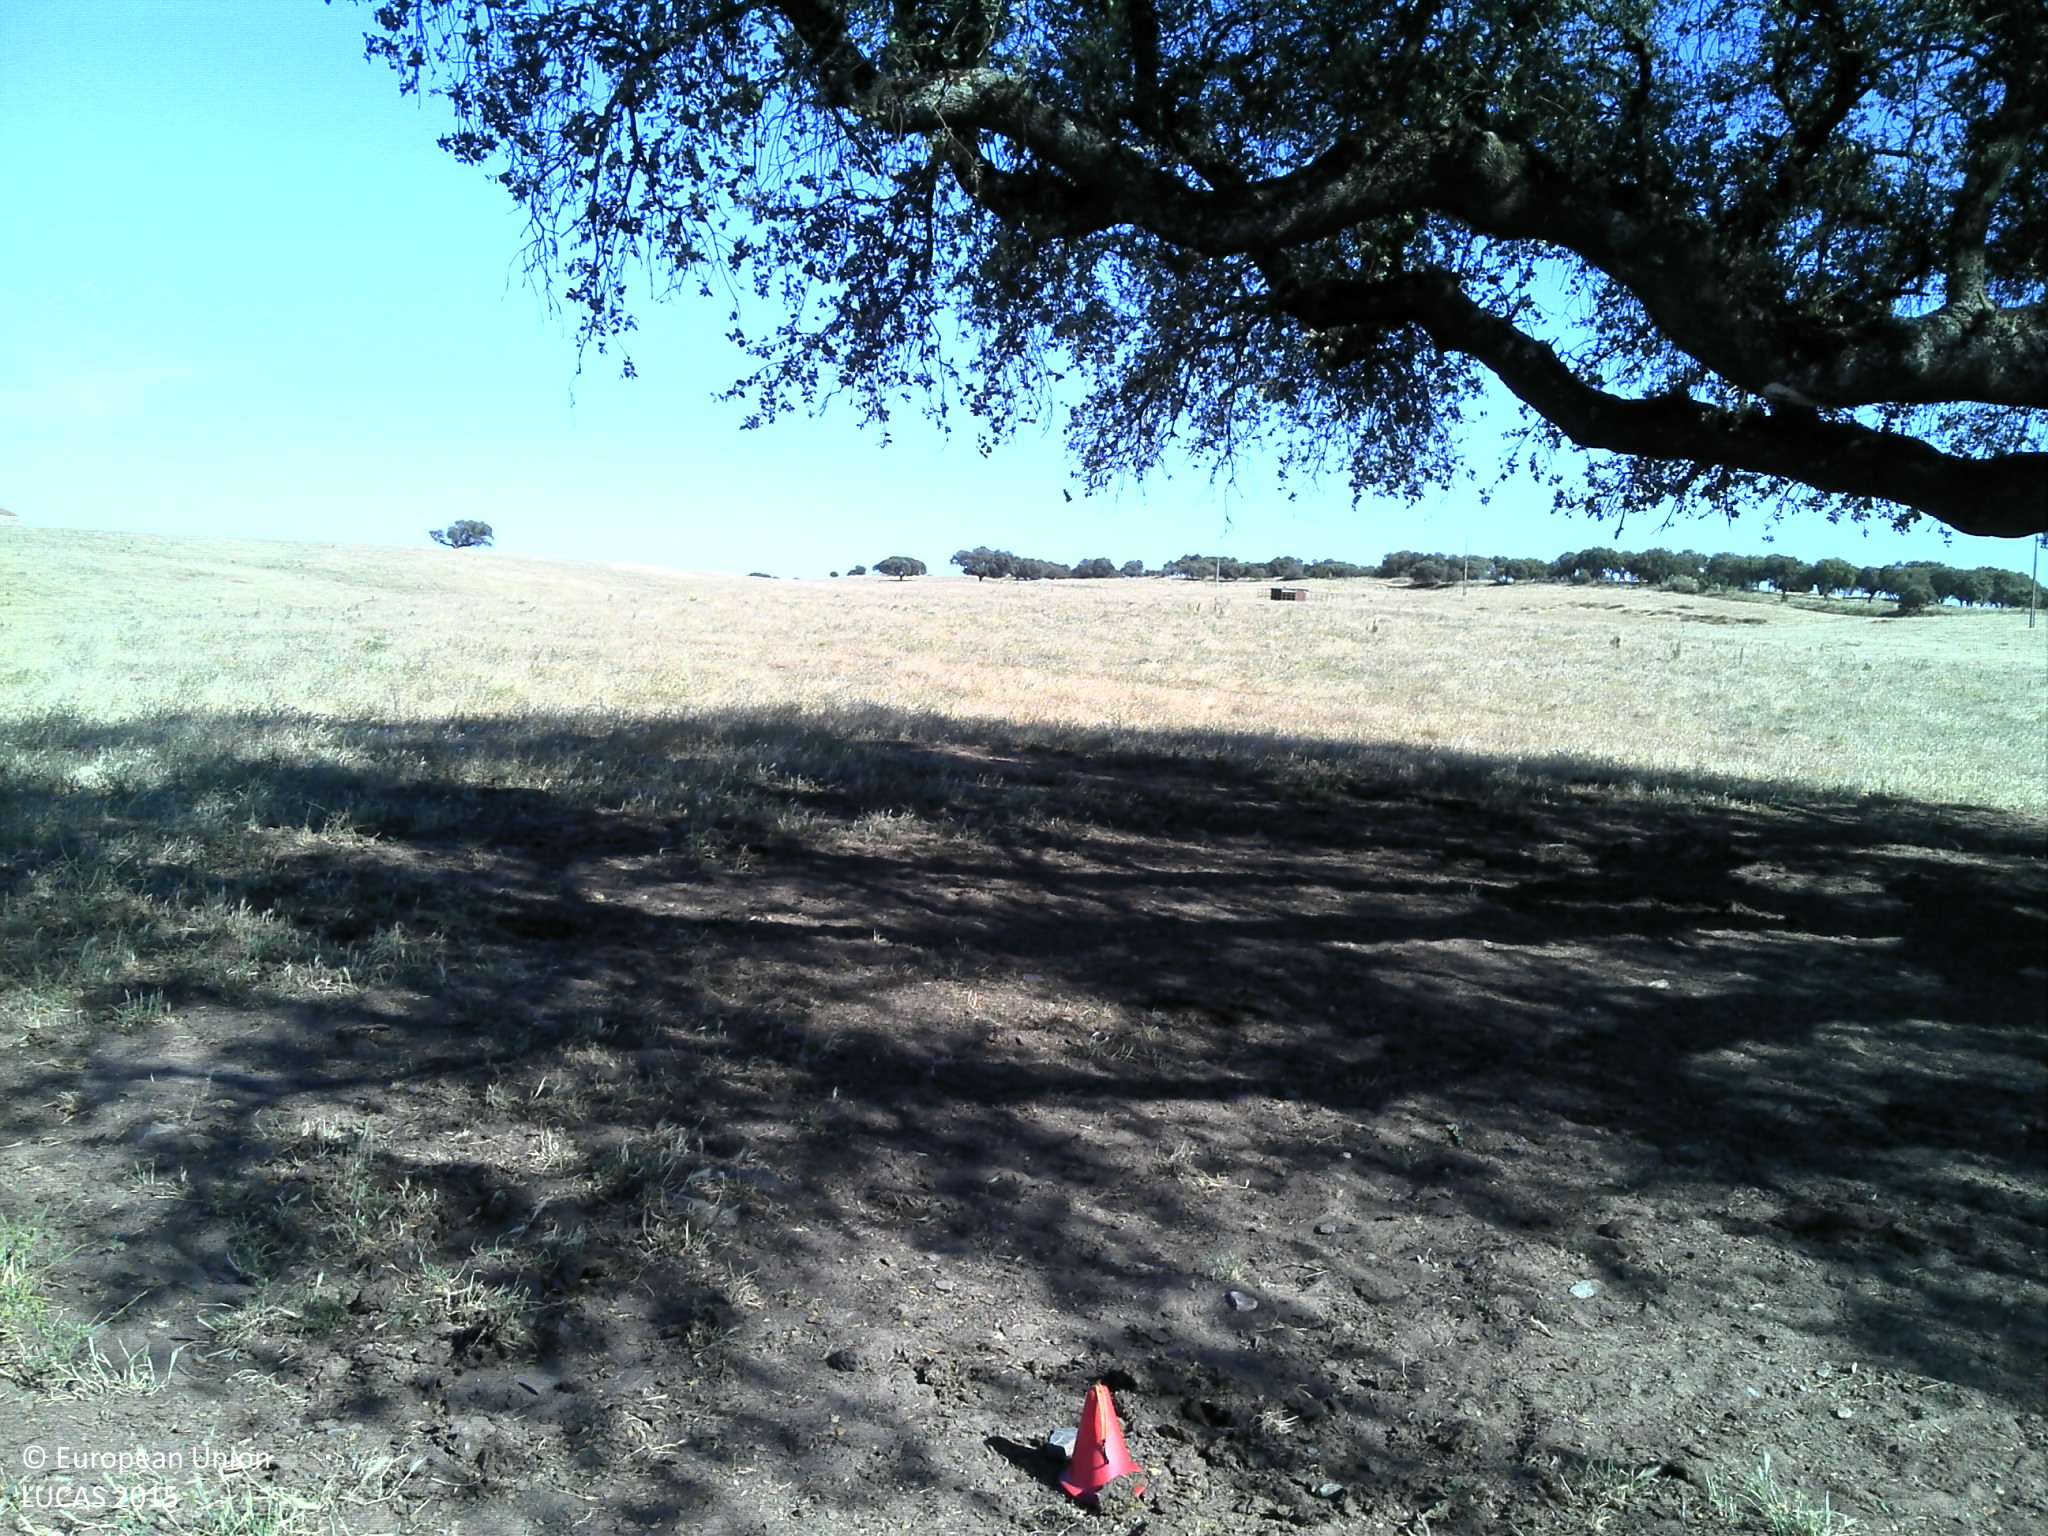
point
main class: Grassland
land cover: Grassland with sparse tree/shrub cover
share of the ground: 50 - 75 %
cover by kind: herbaceous plants 75 %, unconsolidated bare surface 20 %, broadleaved forest trees 5 %
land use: Agriculture (excluding fallow land and kitchen gardens)
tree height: > 5 m
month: May
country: PT
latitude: 39.2529
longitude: -7.6007
